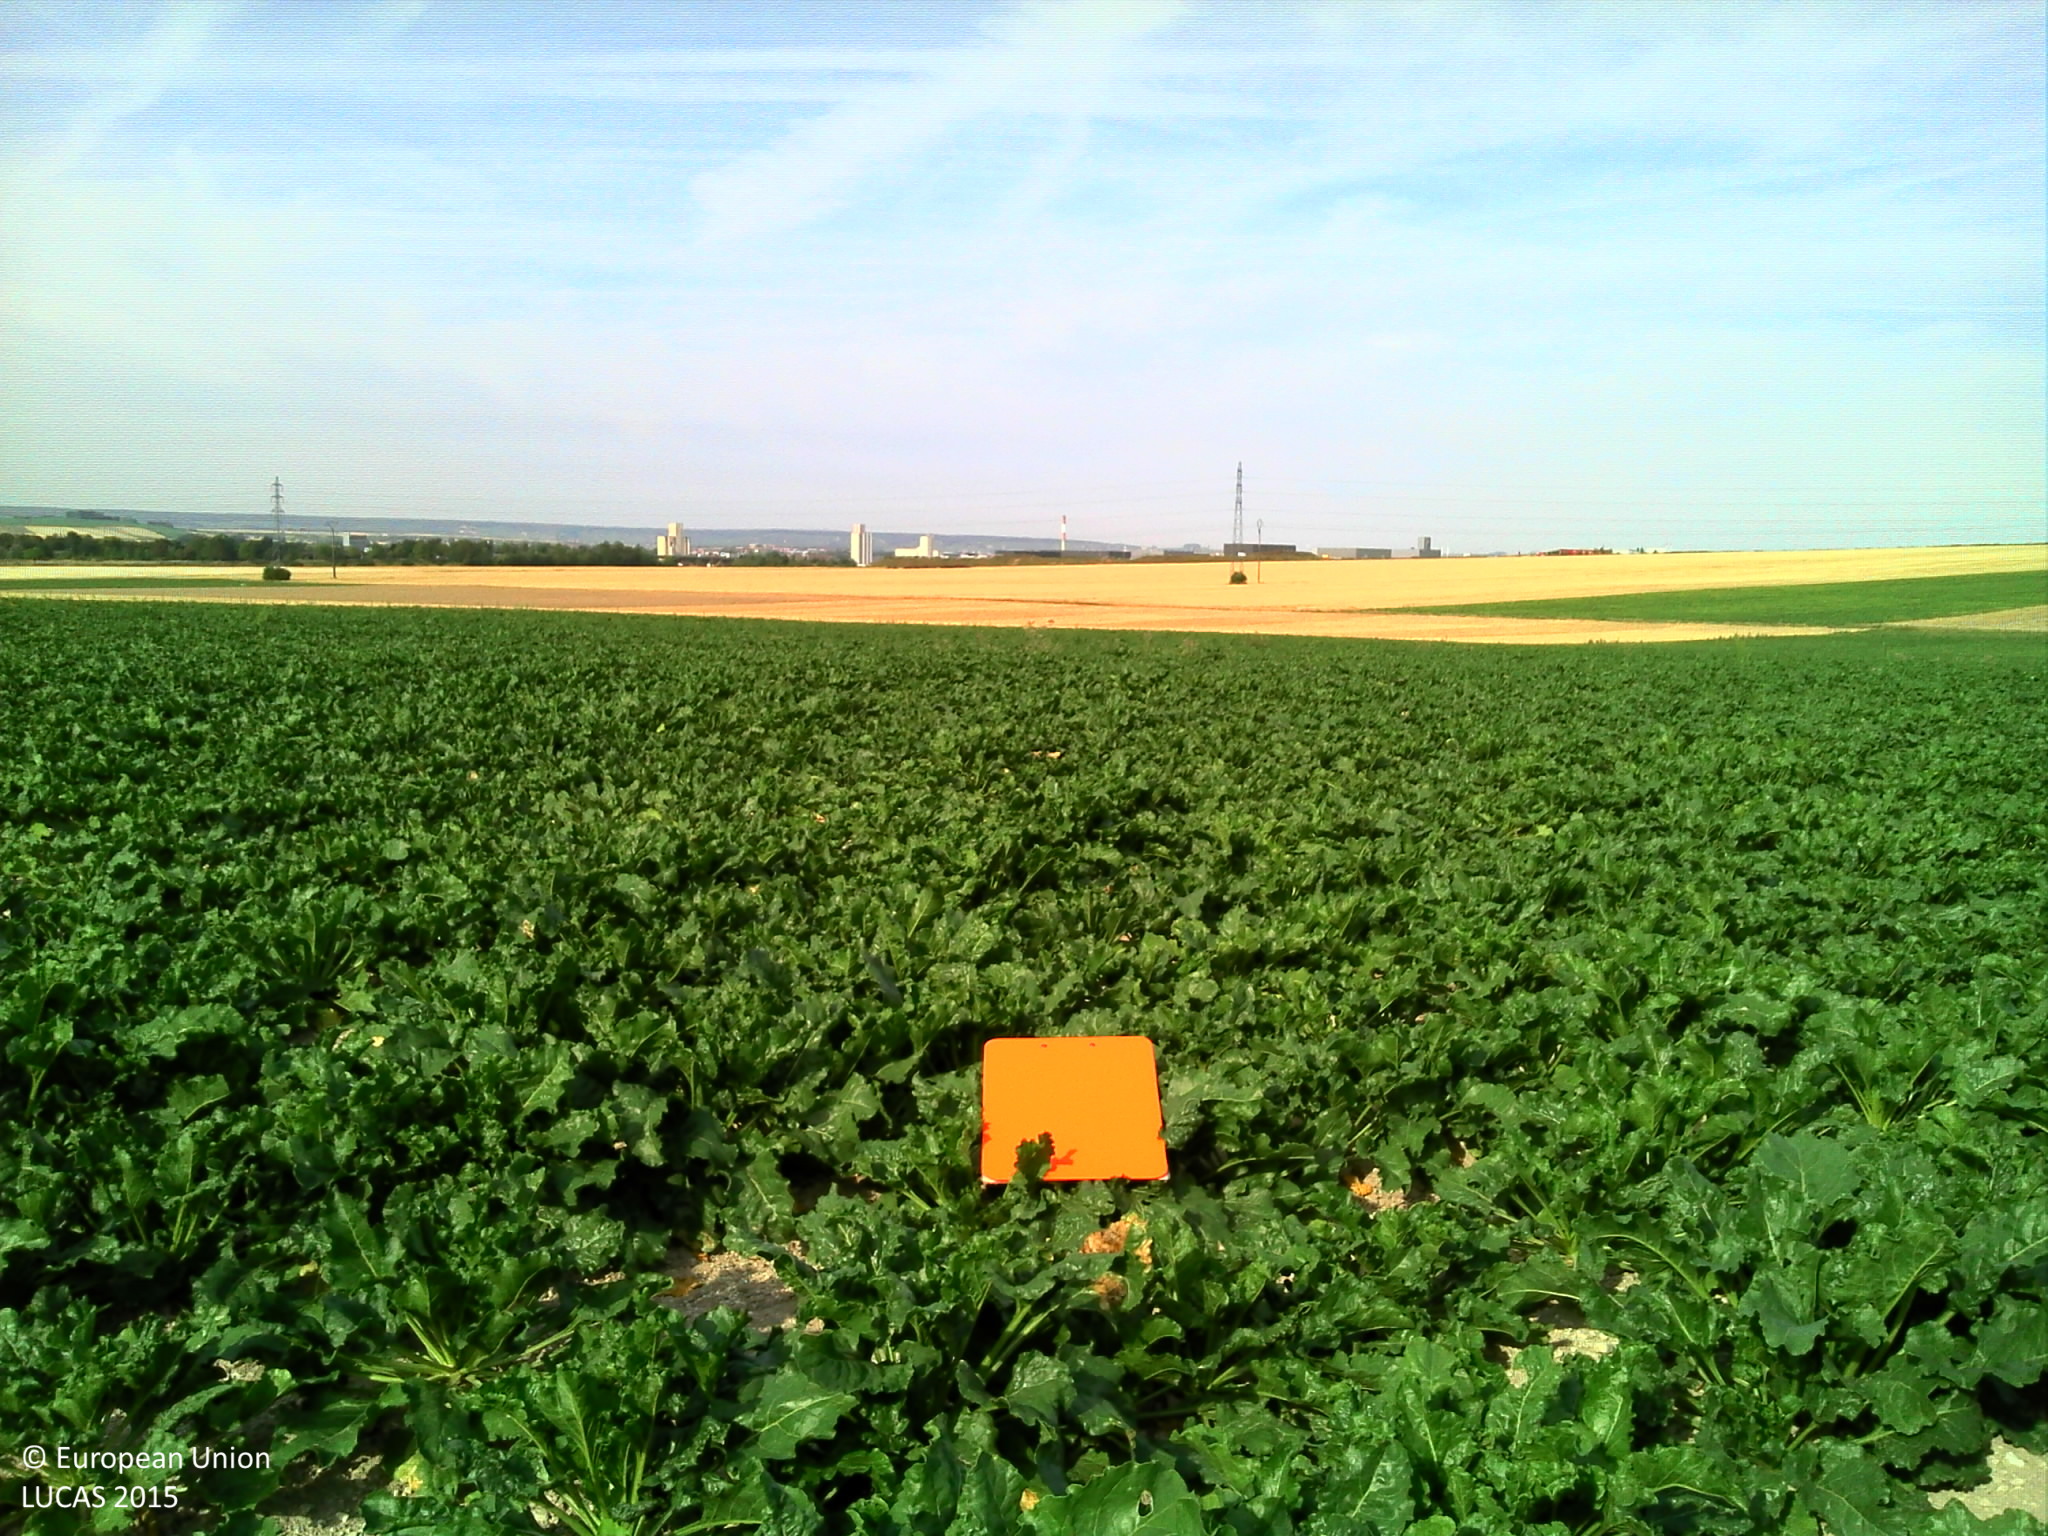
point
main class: Cropland
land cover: Sugar beet
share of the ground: > 75 %
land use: Agriculture (excluding fallow land and kitchen gardens)
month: August
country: FR
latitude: 49.2382
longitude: 4.1031
